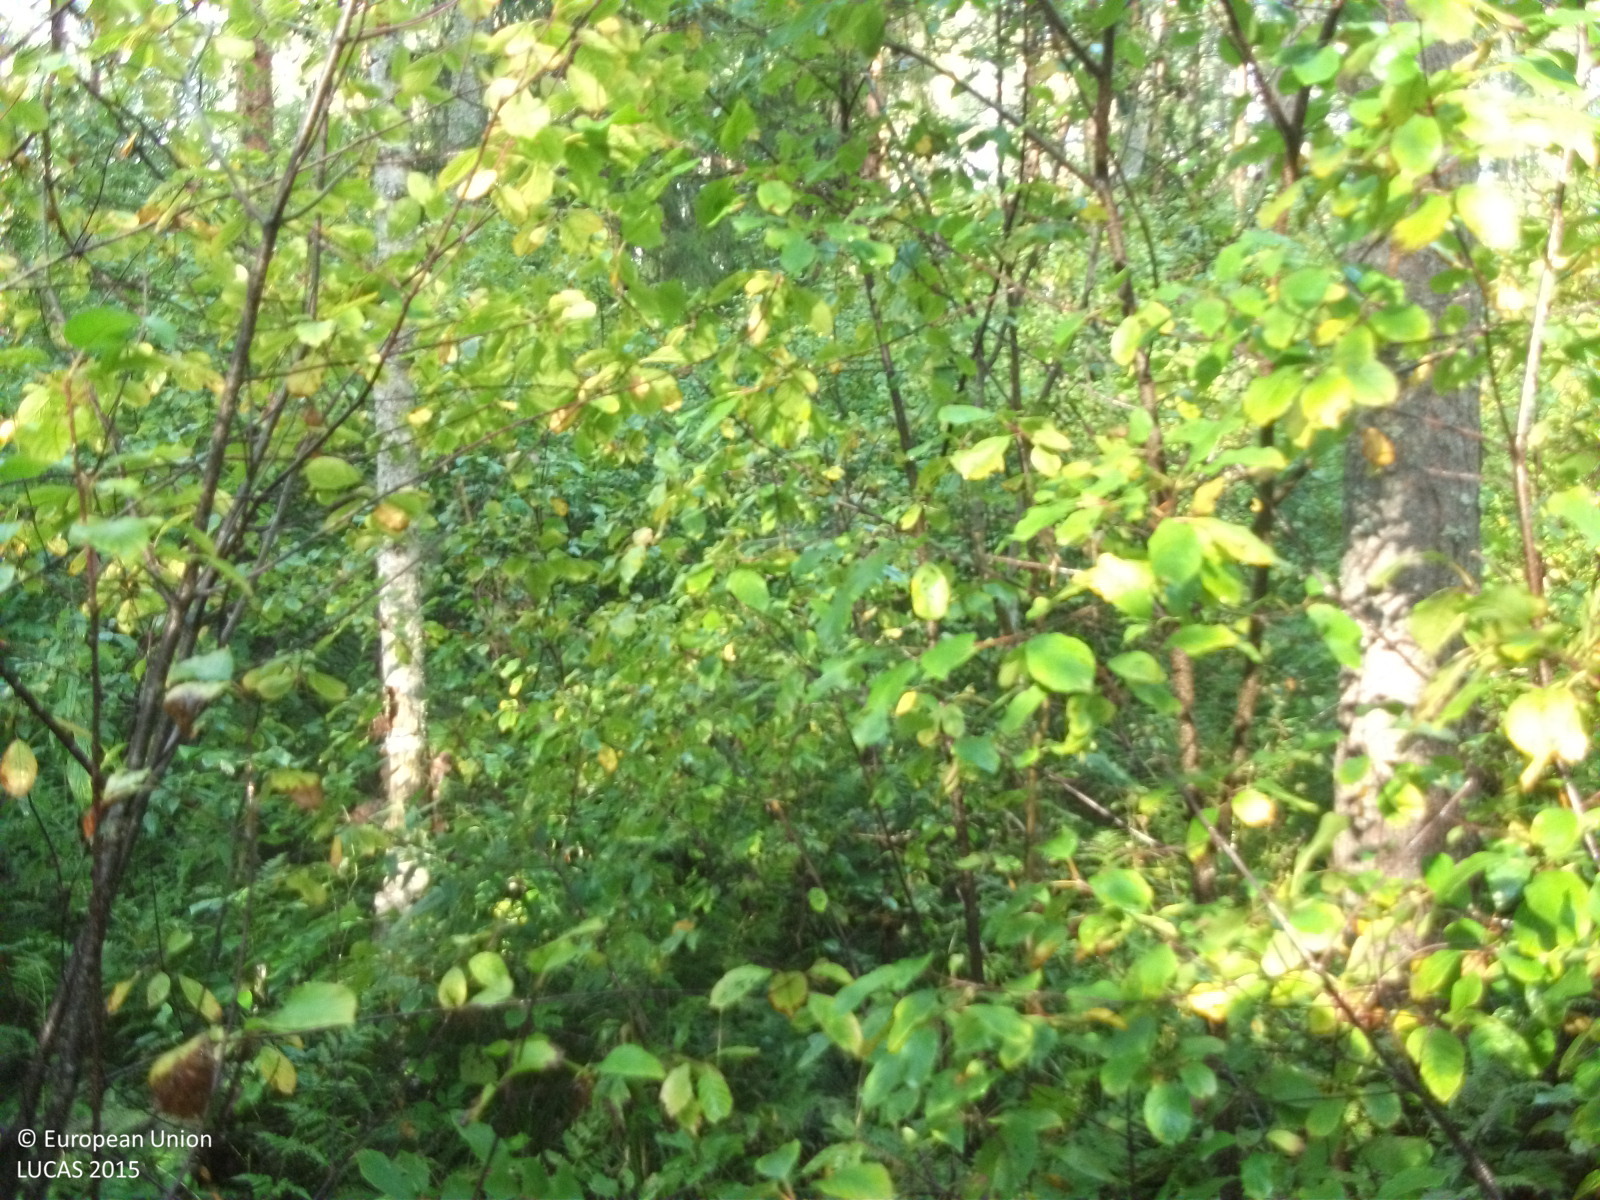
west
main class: Woodland
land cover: Broadleaved woodland
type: non-riverine alder, birch or aspen forest
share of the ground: 50 - 75 %
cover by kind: broadleaved forest trees 55 %, shrubs 30 %, coniferous forest trees 15 %
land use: Forestry
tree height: > 5 m
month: September
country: LV
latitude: 57.5495
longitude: 24.7168
